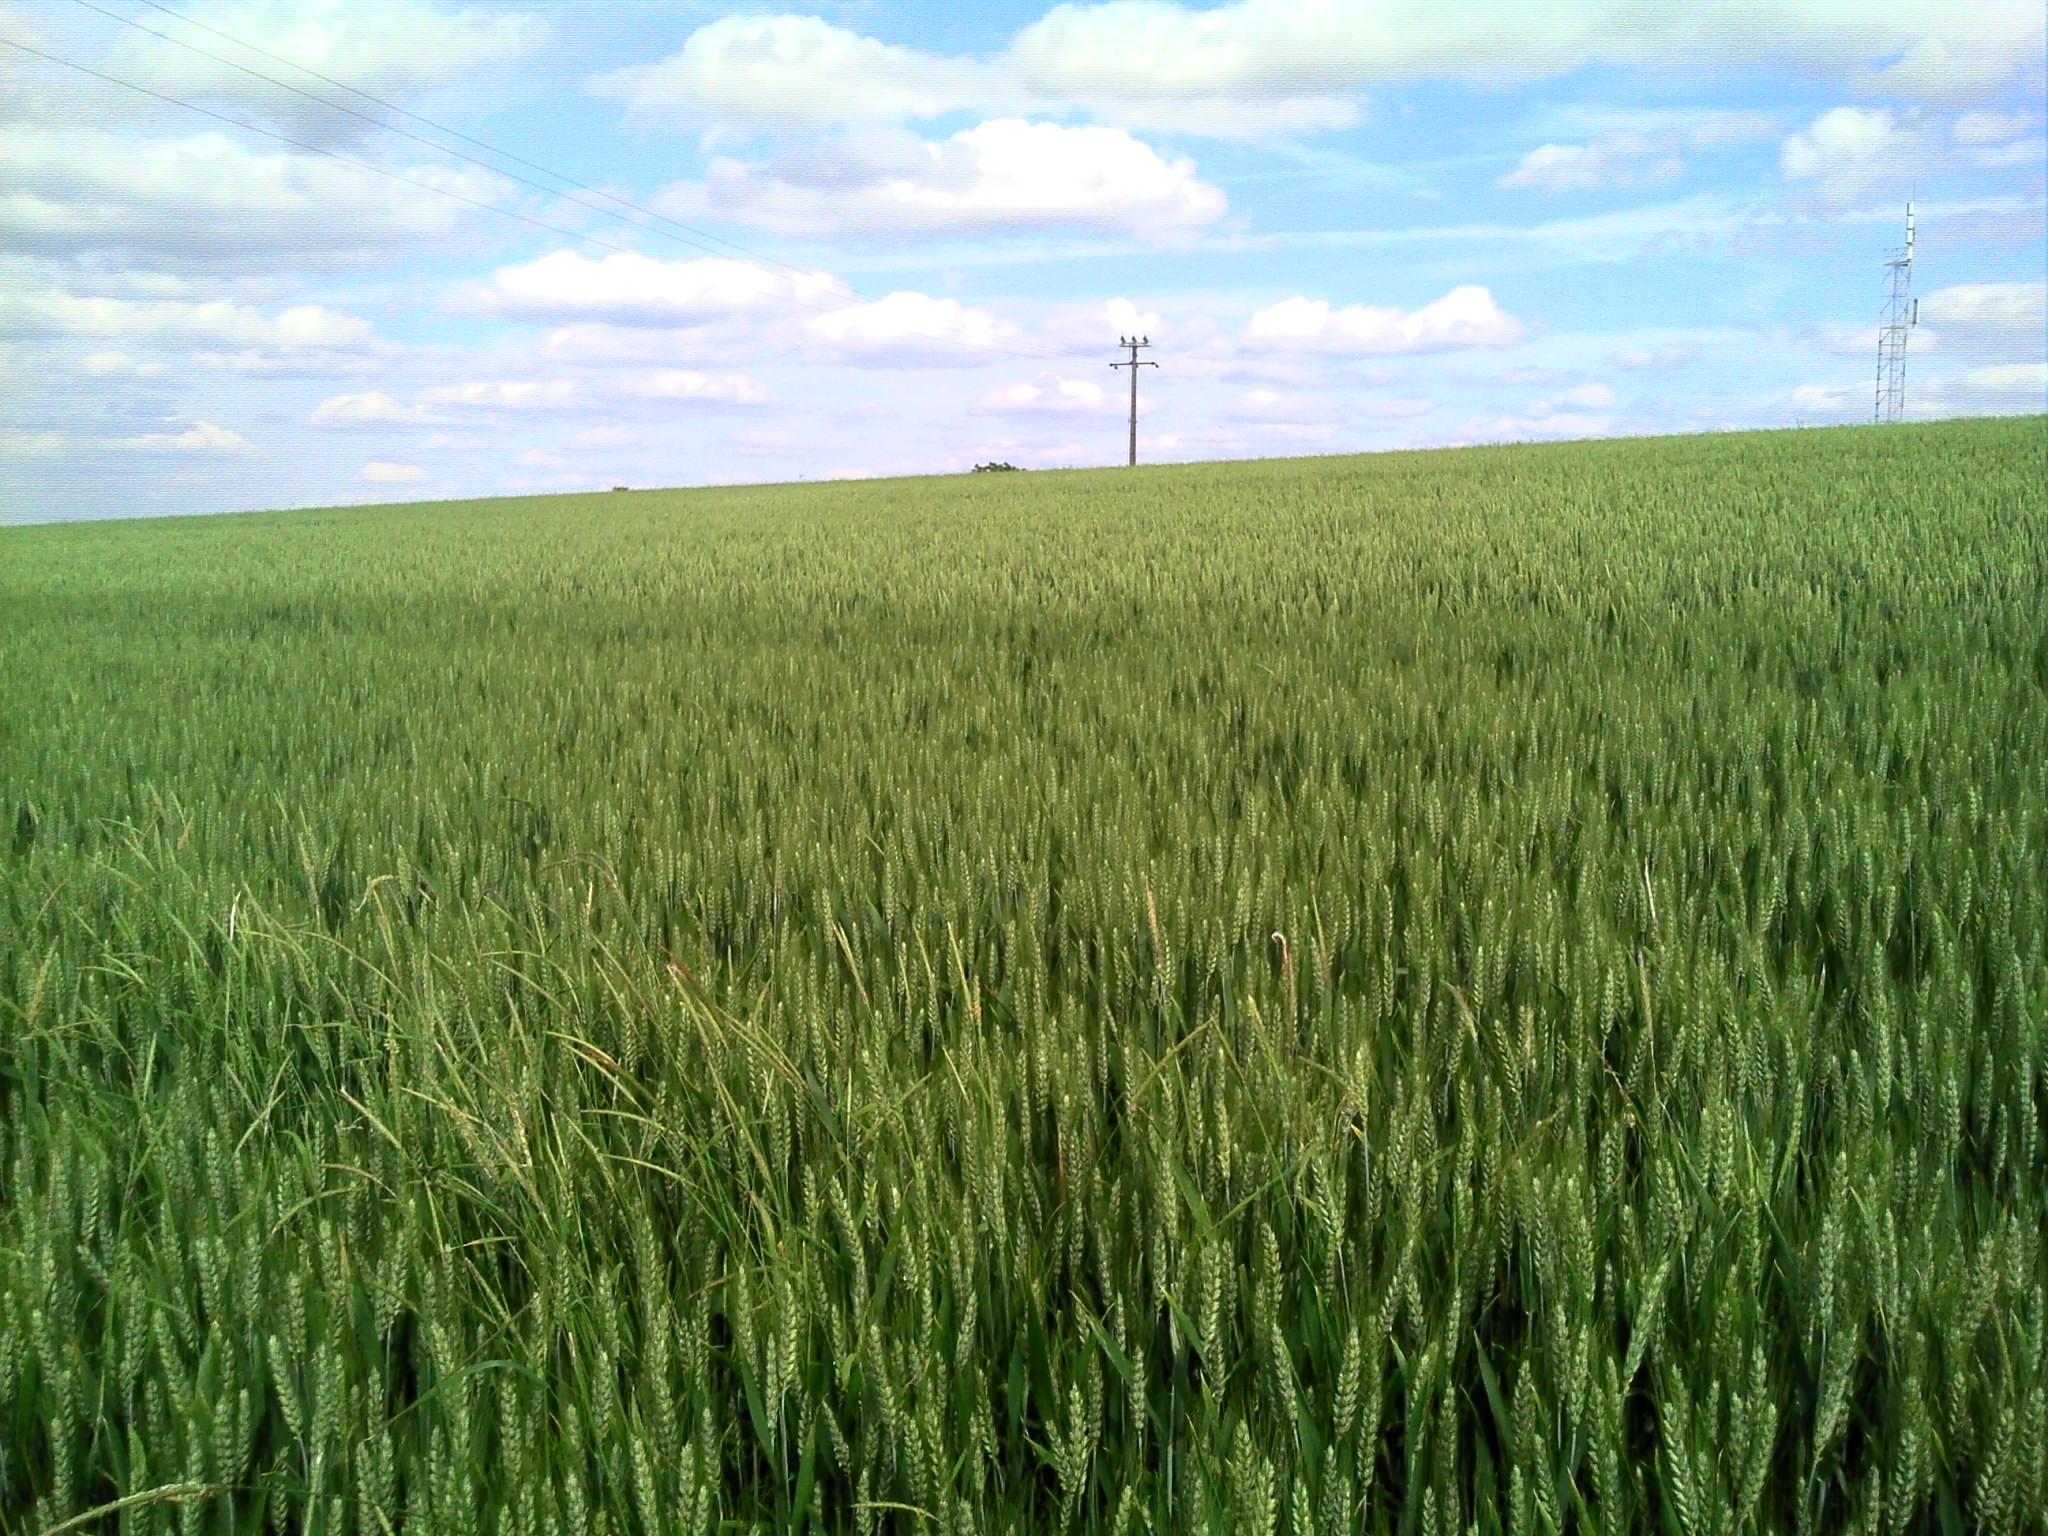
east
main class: Cropland
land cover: Common wheat
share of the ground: > 75 %
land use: Agriculture (excluding fallow land and kitchen gardens)
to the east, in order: Common wheat; Electric lines; Common wheat; Grass margins; Artificial constructions in urban areas; Grass margins; Paved roads, cycling and walking lanes; Grass margins; Maize
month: May
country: FR
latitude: 46.9140
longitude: 0.3817
